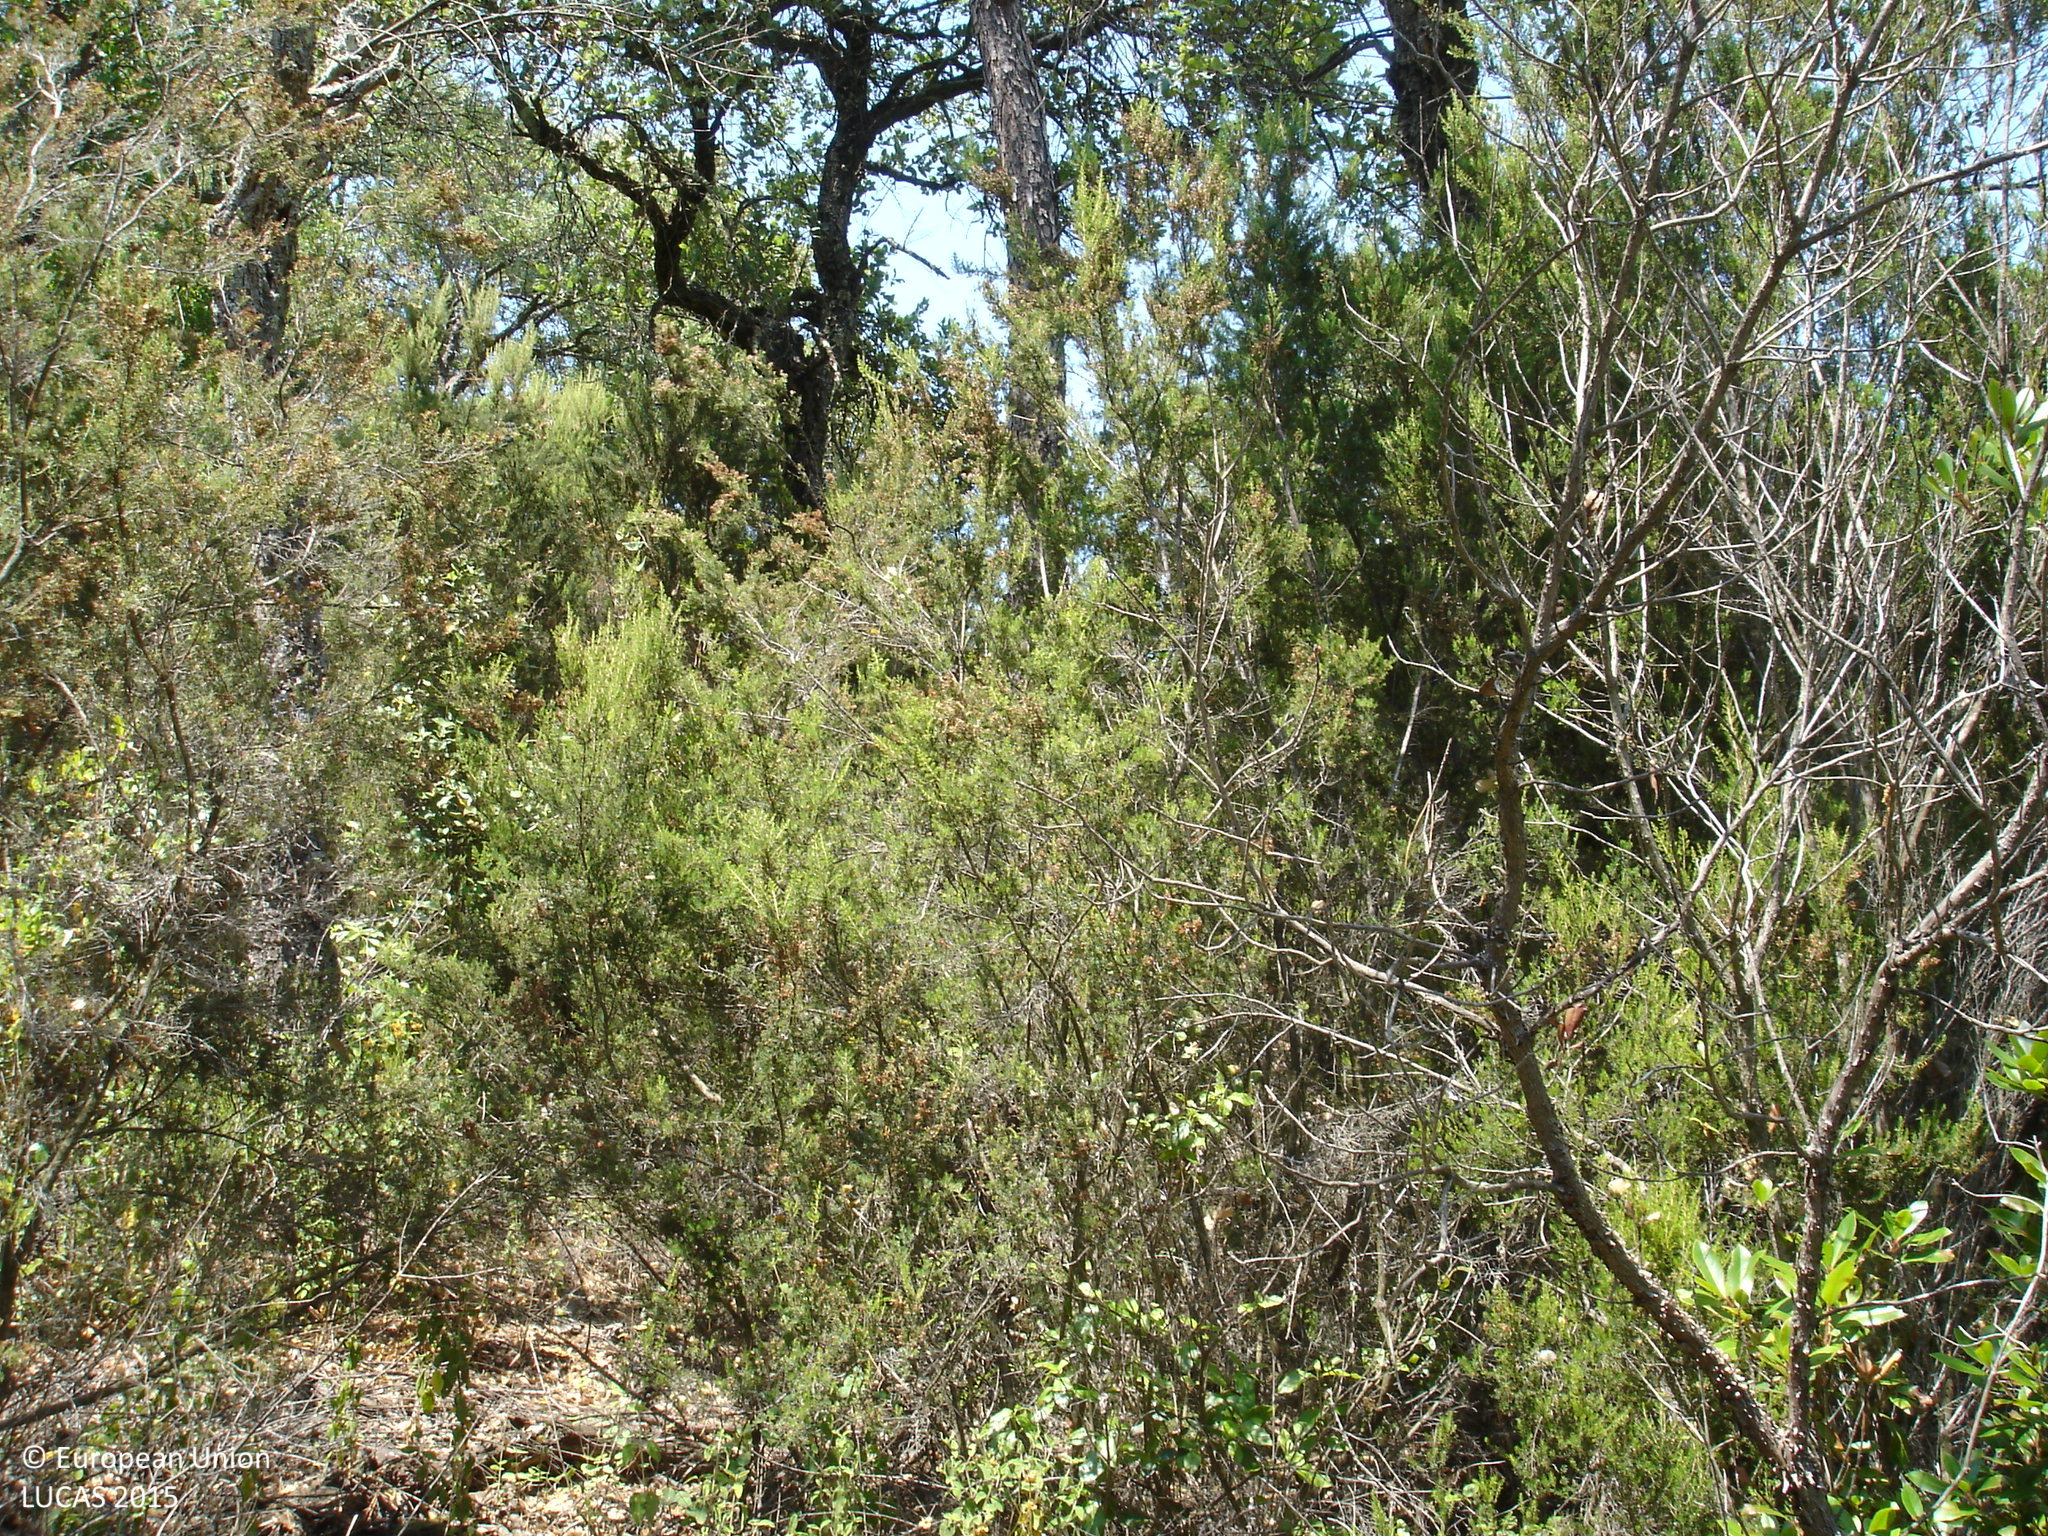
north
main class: Woodland
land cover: Other mixed woodland
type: thermophilous deciduous forest
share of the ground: > 75 %
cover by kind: coniferous forest trees 40 %, broadleaved forest trees 40 %, shrubs 15 %, herbaceous plants 5 %
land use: Forestry
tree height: > 5 m
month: June
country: ES
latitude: 41.7122
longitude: 2.6012
